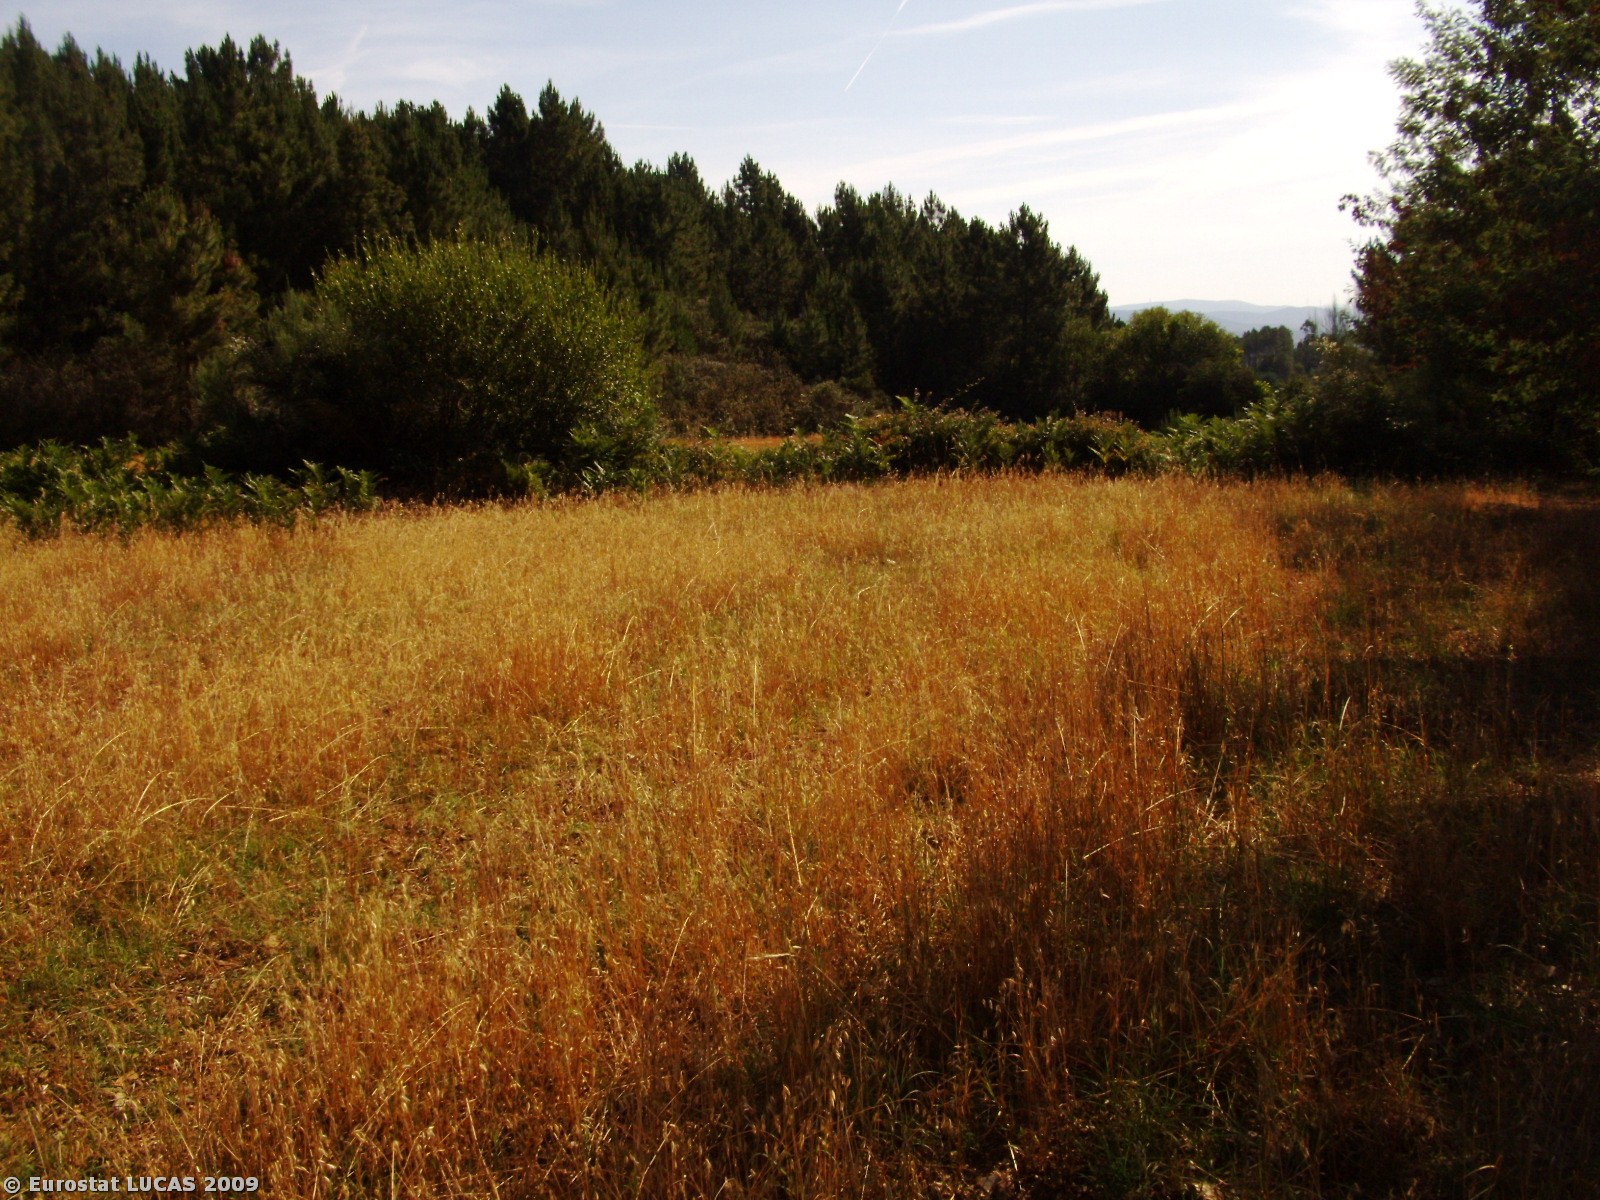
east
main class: Woodland
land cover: Coniferous woodland
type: coniferous forest of the mediterranean region
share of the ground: > 75 %
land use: Forestry
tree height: > 5 m
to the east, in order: Coniferous woodland; Tracks; Broadleaved woodland; Arable land (only in case pi); Broadleaved woodland; Arable land (only in case pi)
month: June
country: PT
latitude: 40.1482
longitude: -7.3453
